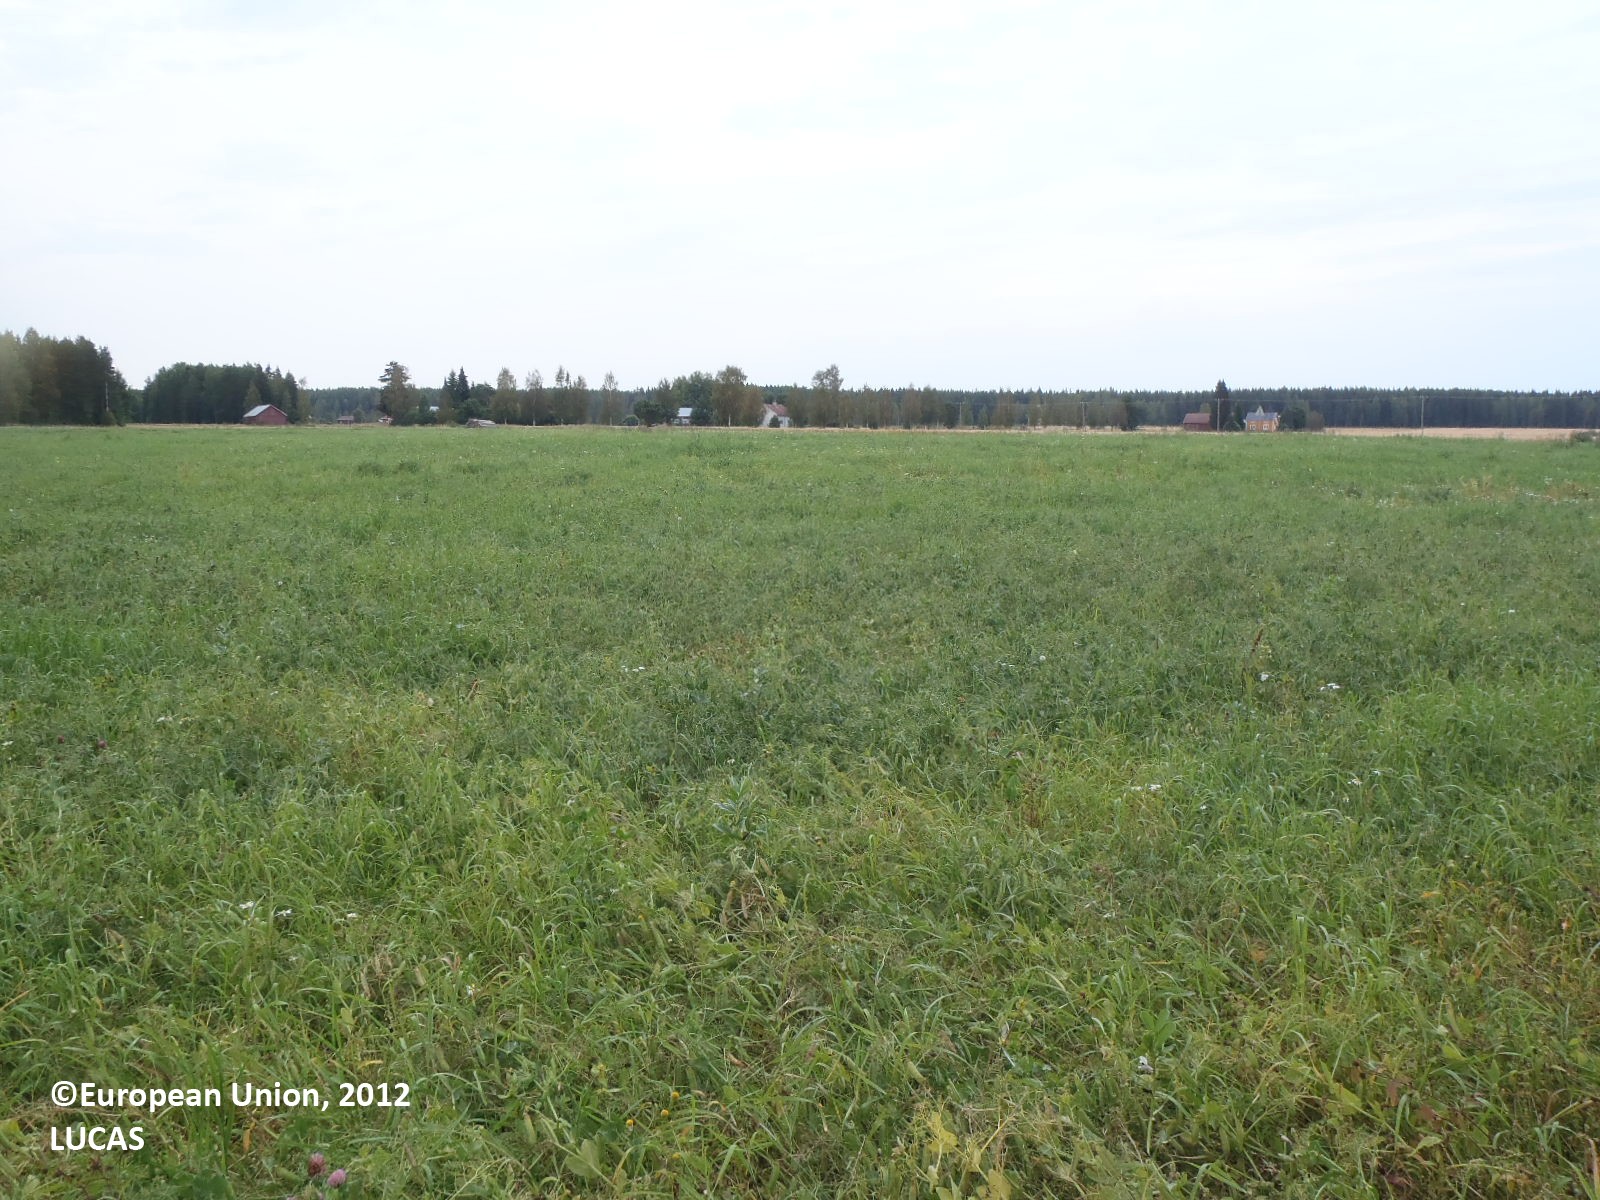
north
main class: Cropland
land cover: Mixed cereals for fodder
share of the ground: > 75 %
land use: Agriculture (excluding fallow land and kitchen gardens)
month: August
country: FI
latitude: 60.9205
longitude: 22.4805
